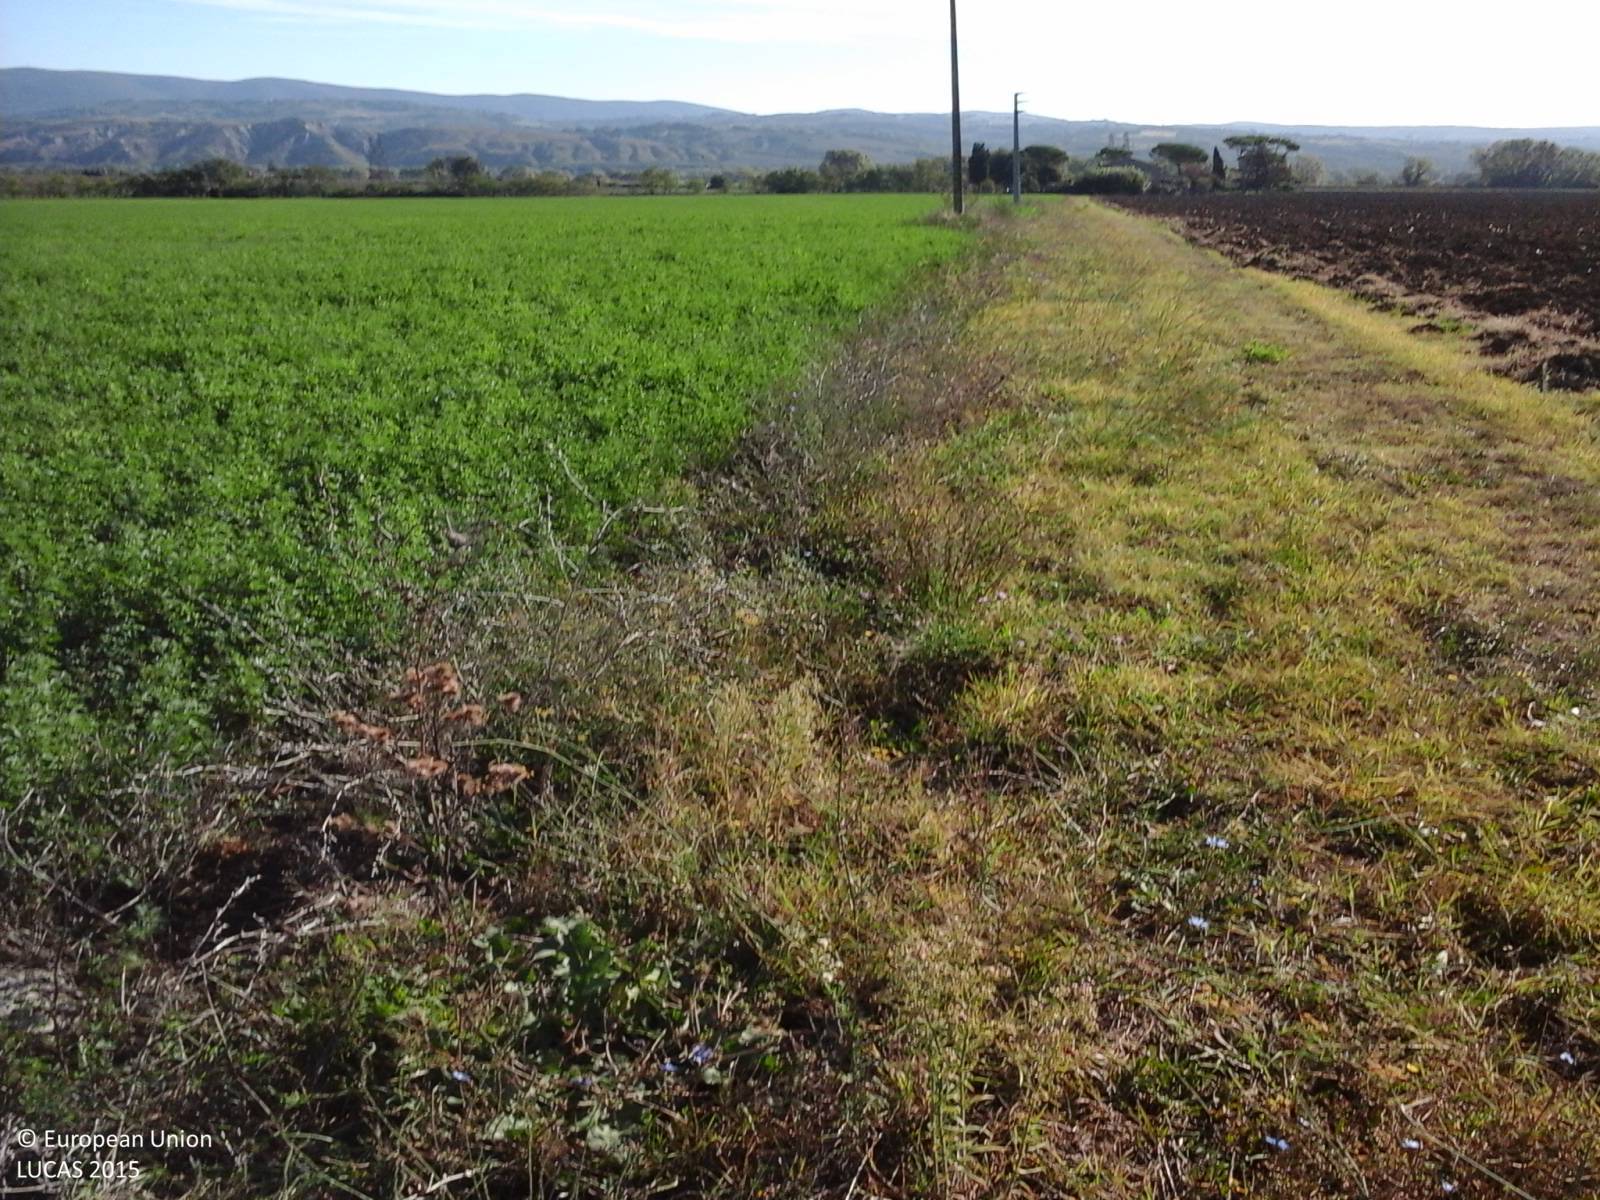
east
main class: Cropland
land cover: Lucerne
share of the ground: > 75 %
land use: Agriculture (excluding fallow land and kitchen gardens)
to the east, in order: Lucerne
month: September
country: IT
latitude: 42.5388
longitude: 12.2451
